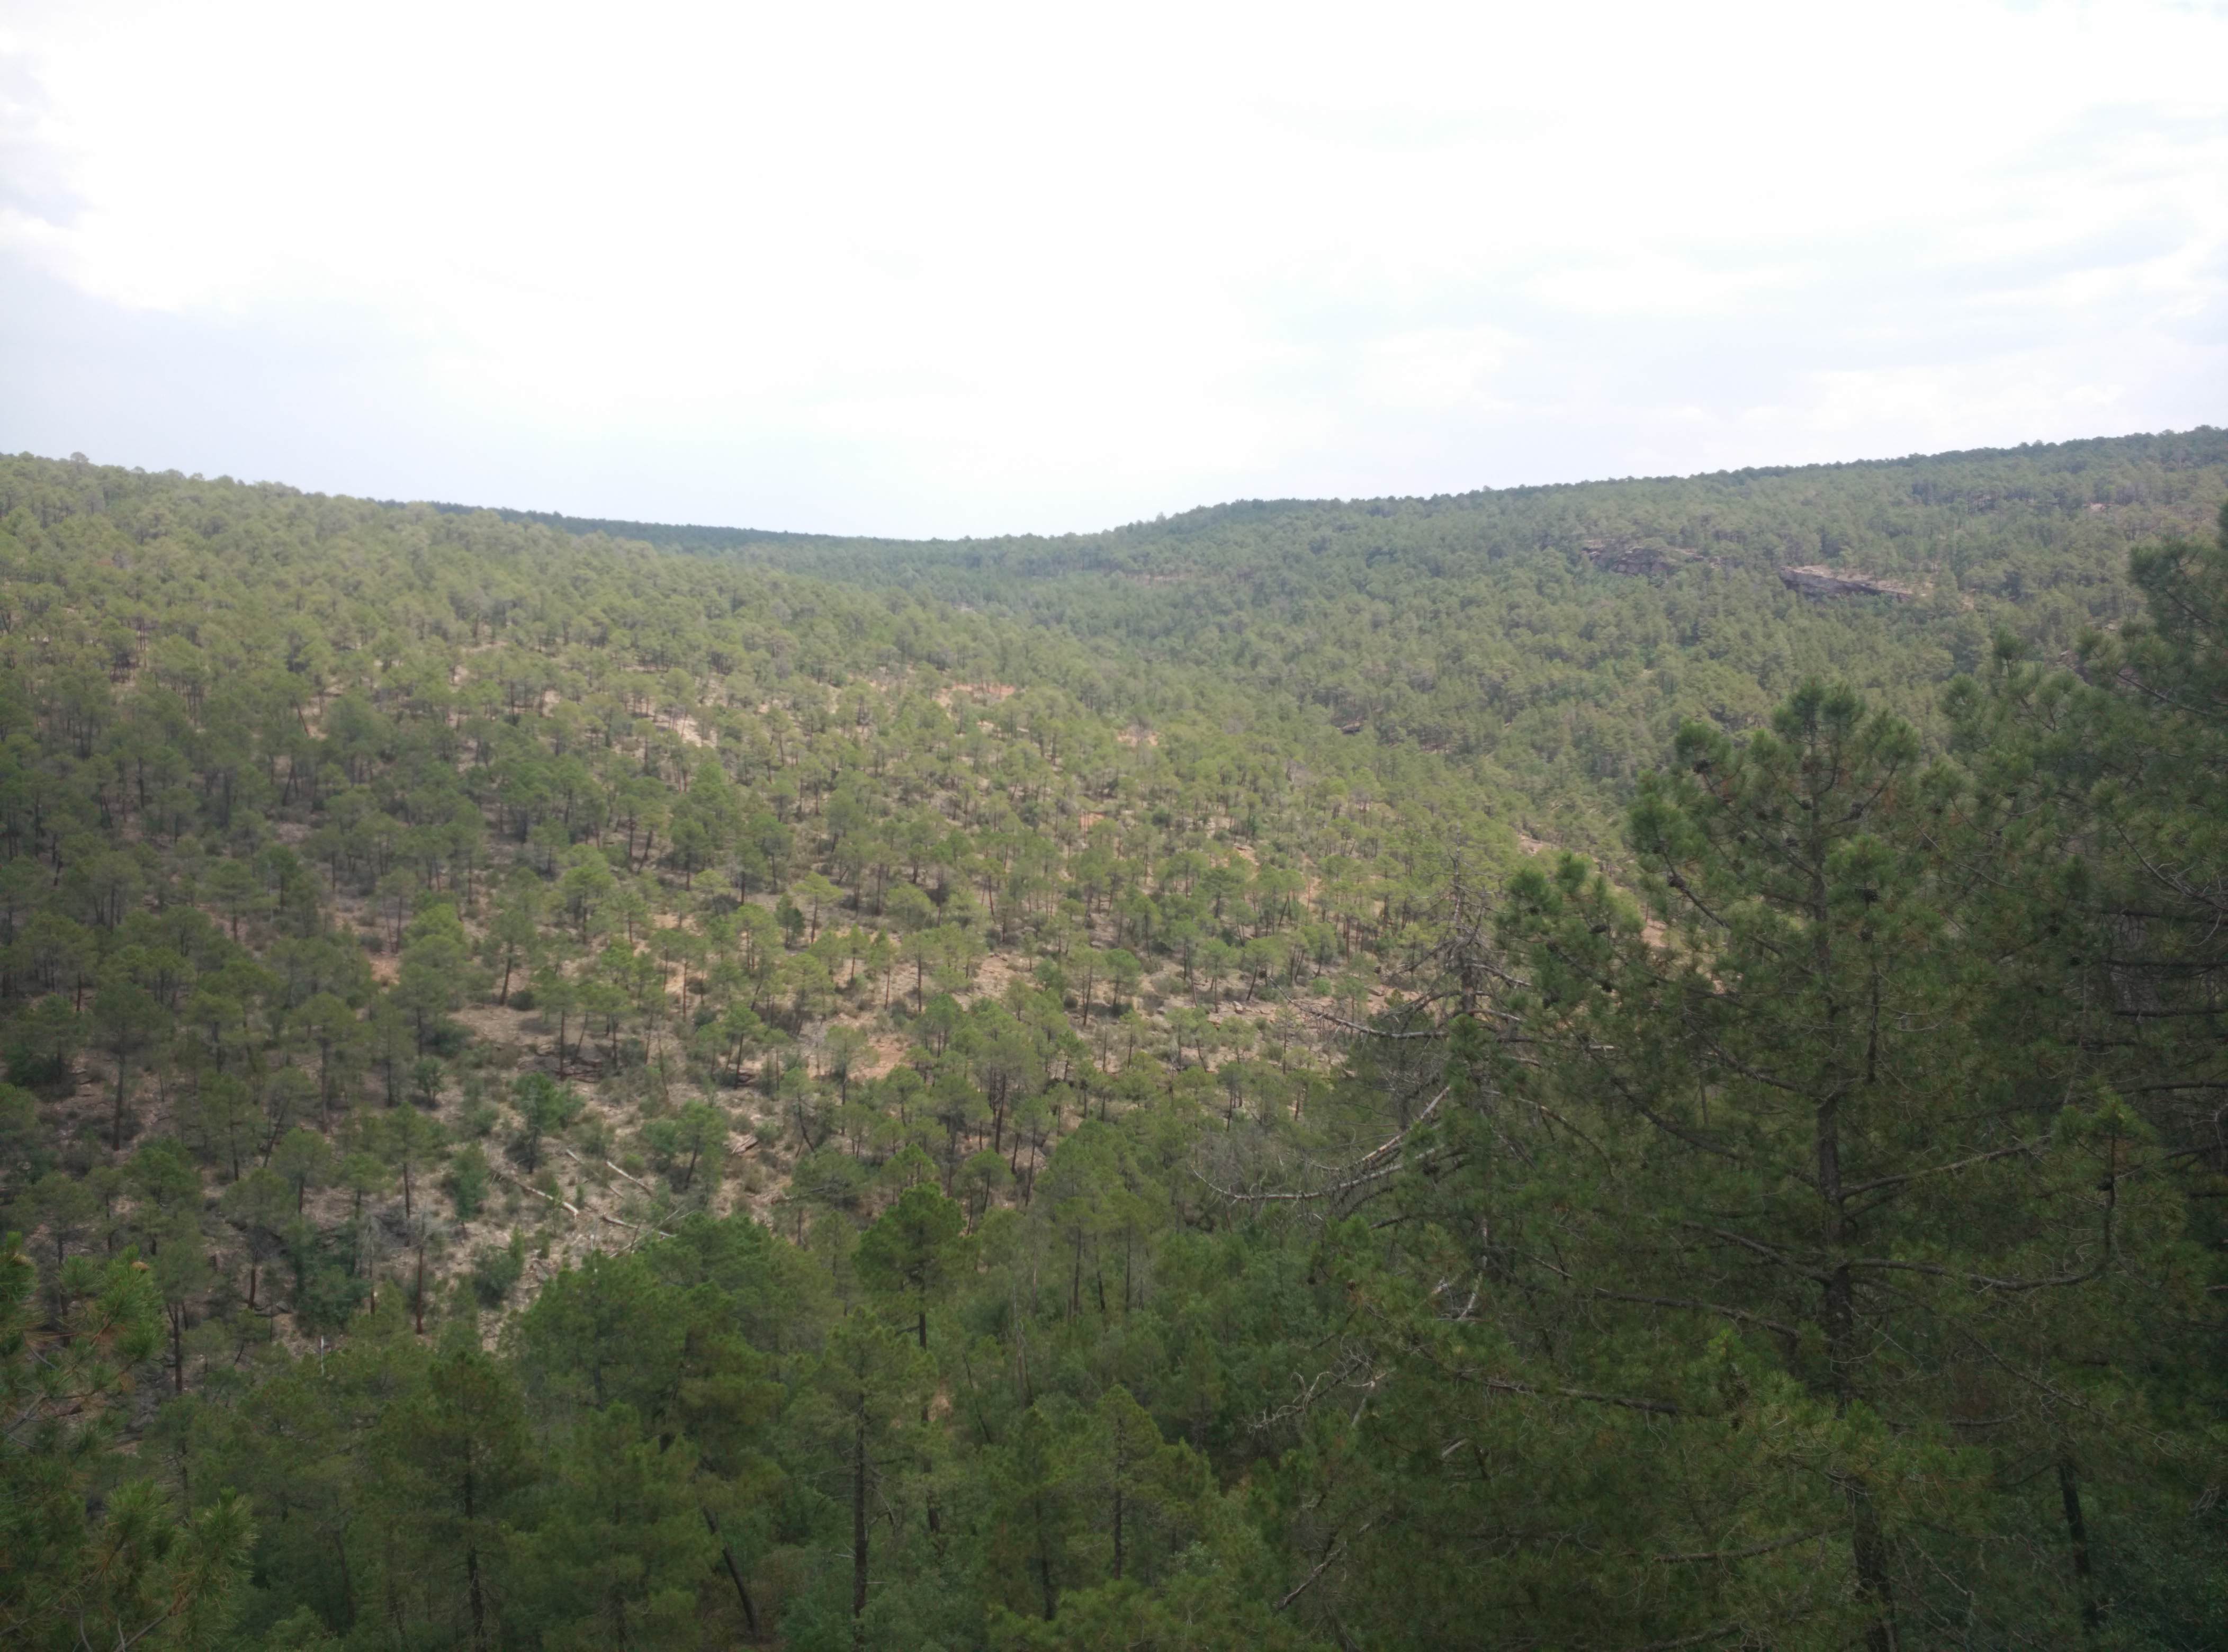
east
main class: Woodland
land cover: Pine dominated coniferous woodland
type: coniferous forest of the mediterranean region
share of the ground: > 75 %
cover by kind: coniferous forest trees 95 %, unconsolidated bare surface 5 %
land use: Semi-natural and natural areas not in use
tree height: > 5 m
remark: Burnt area
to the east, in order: Pine dominated coniferous woodland
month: July
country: ES
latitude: 40.8384
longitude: -2.0373
